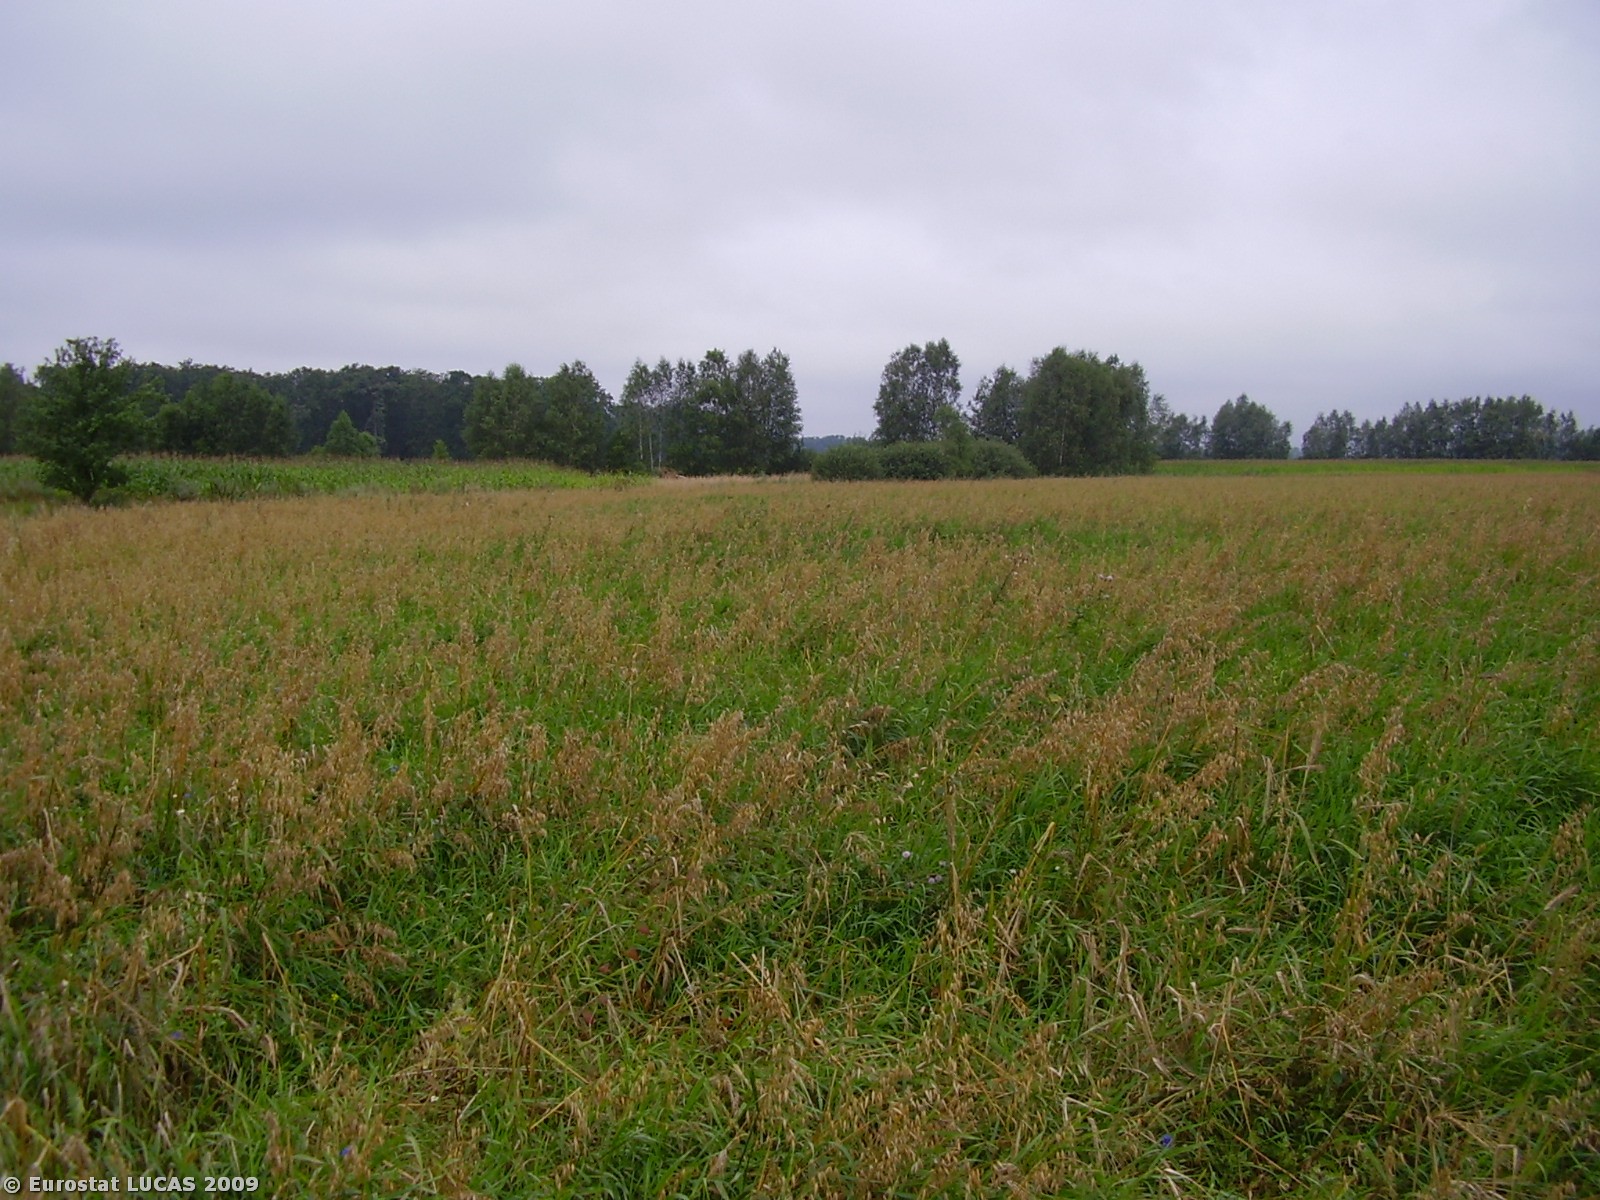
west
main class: Grassland
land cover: Spontaneously vegetated surfaces
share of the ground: > 75 %
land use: Fallow land
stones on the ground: < 10 %
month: April
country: PL
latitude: 51.5314
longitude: 16.8278
